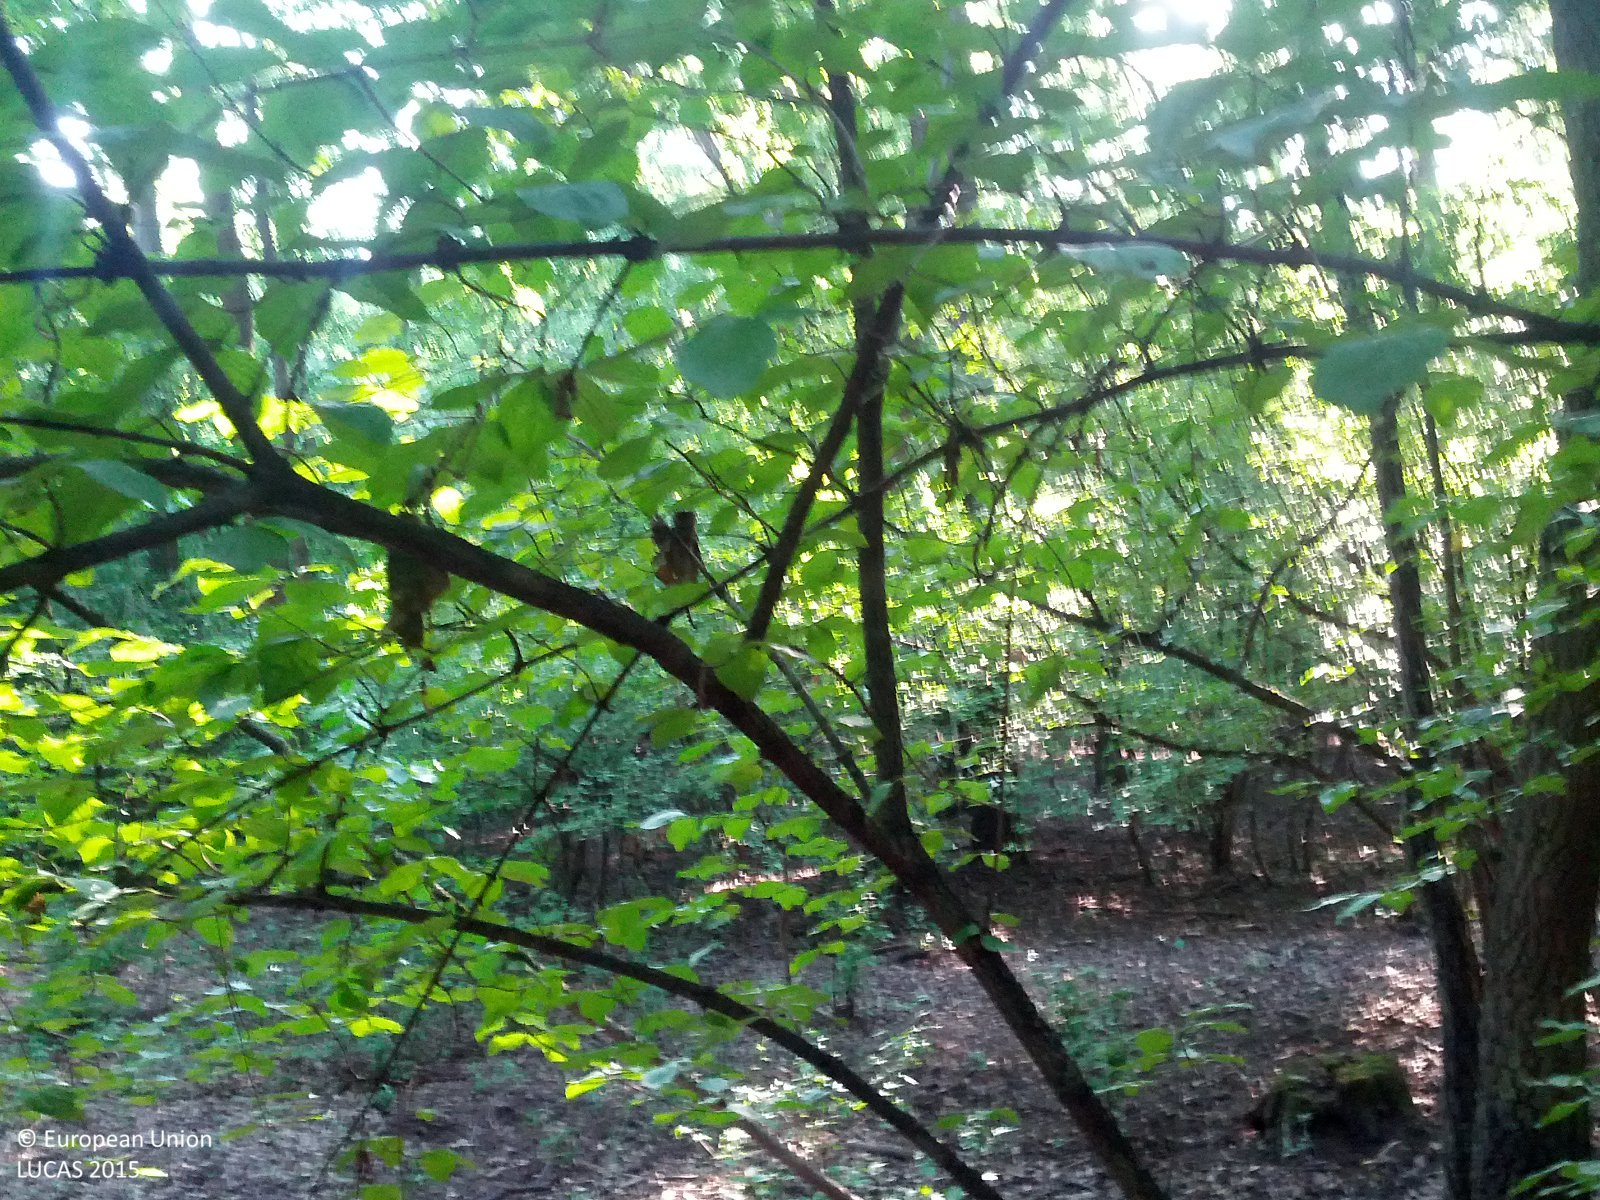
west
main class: Woodland
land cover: Broadleaved woodland
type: mesophytic deciduous forest
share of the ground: > 75 %
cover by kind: broadleaved forest trees 90 %, unconsolidated bare surface 10 %
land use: Forestry
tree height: > 5 m
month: July
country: AT
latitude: 48.3894
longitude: 16.5557
